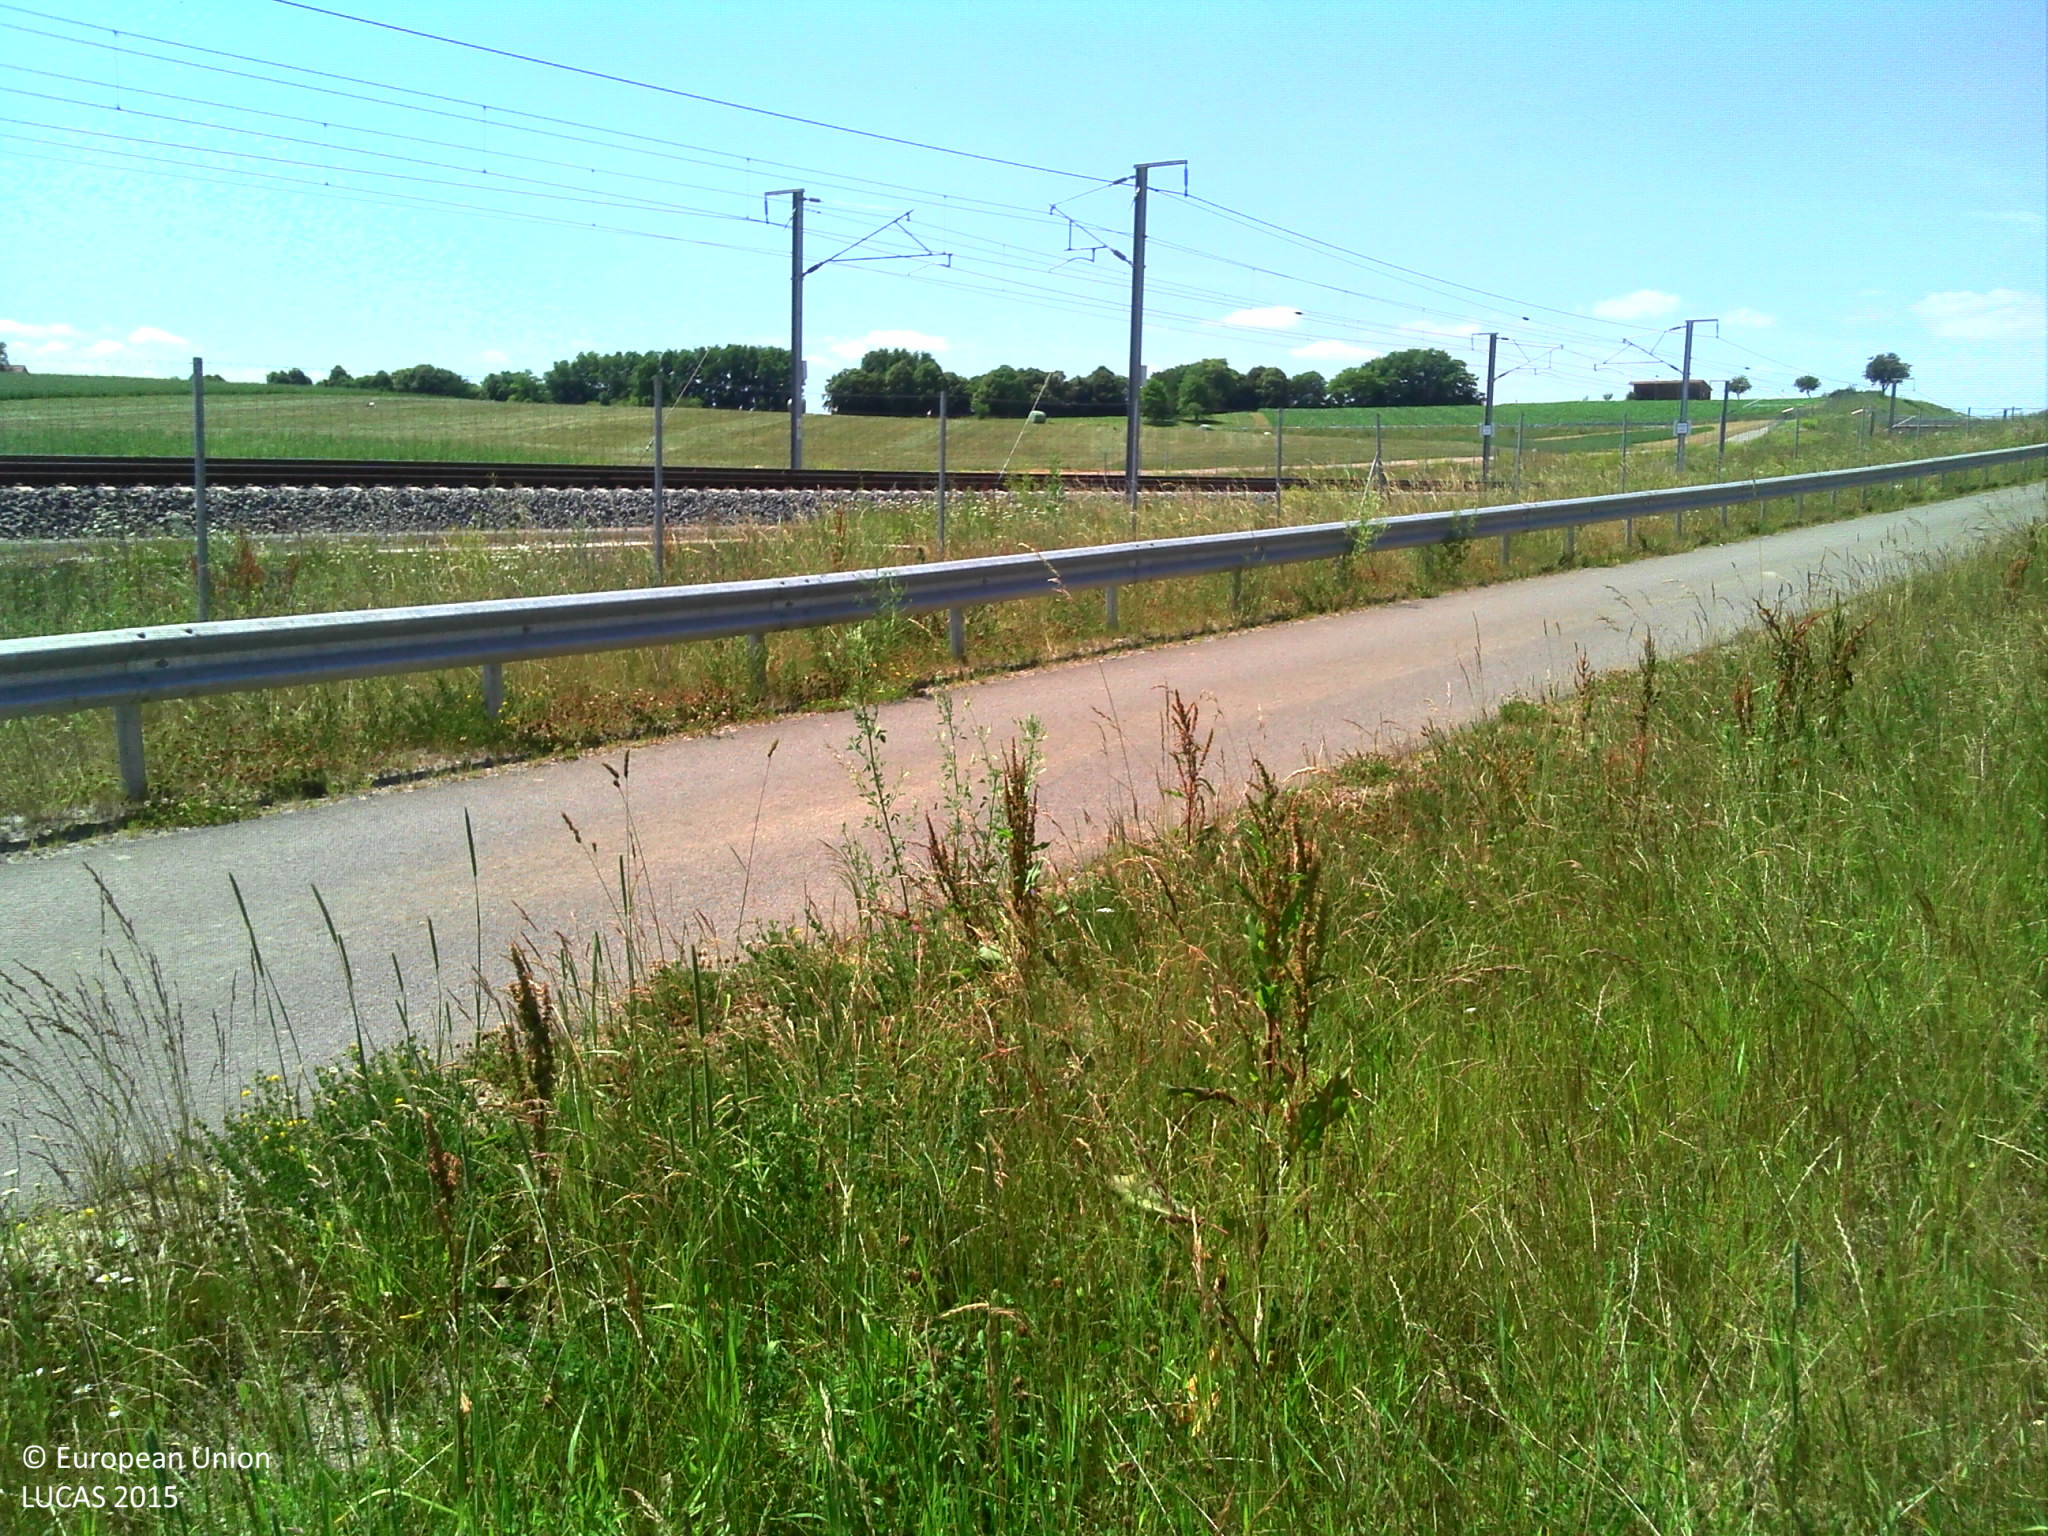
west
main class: Grassland
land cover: Grassland without tree/shrub cover
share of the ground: > 75 %
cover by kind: herbaceous plants 100 %
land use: Agriculture (excluding fallow land and kitchen gardens)
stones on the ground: < 10 %
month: June
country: FR
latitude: 48.7182
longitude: 7.5405
